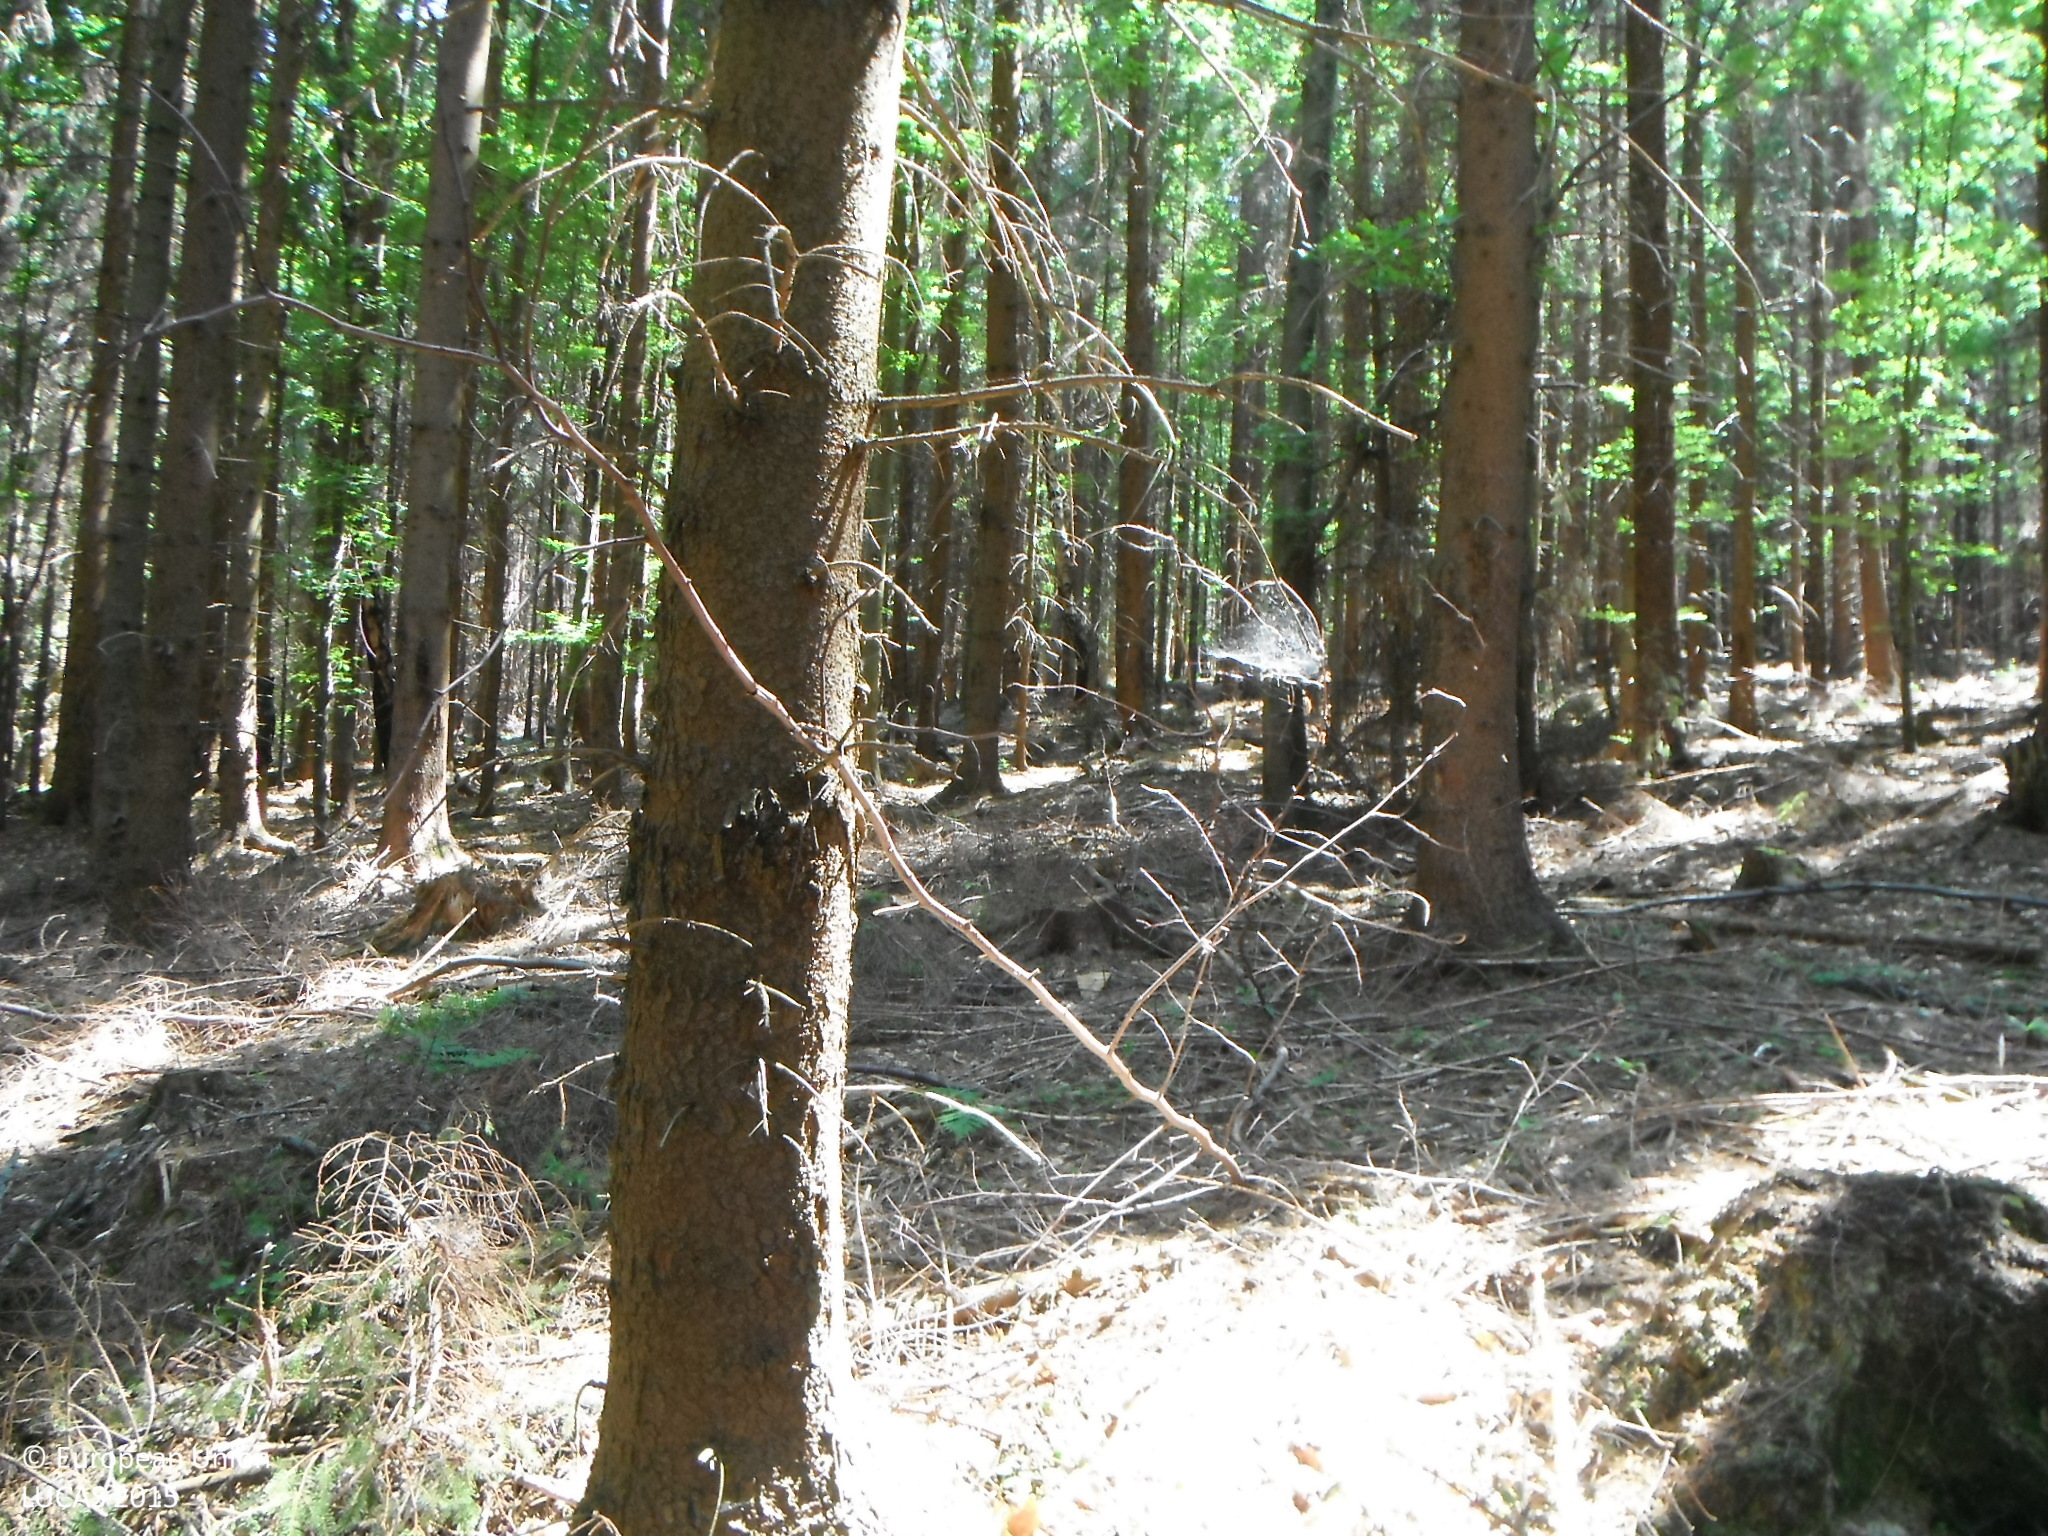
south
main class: Woodland
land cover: Spruce dominated mixed woodland
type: hemiboreal forest and nemoral coniferous forest and mixed broadleaved-coniferous forest
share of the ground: > 75 %
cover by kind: coniferous forest trees 70 %, broadleaved forest trees 30 %
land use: Forestry
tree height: > 5 m
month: July
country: SK
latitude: 49.3718
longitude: 19.2654
